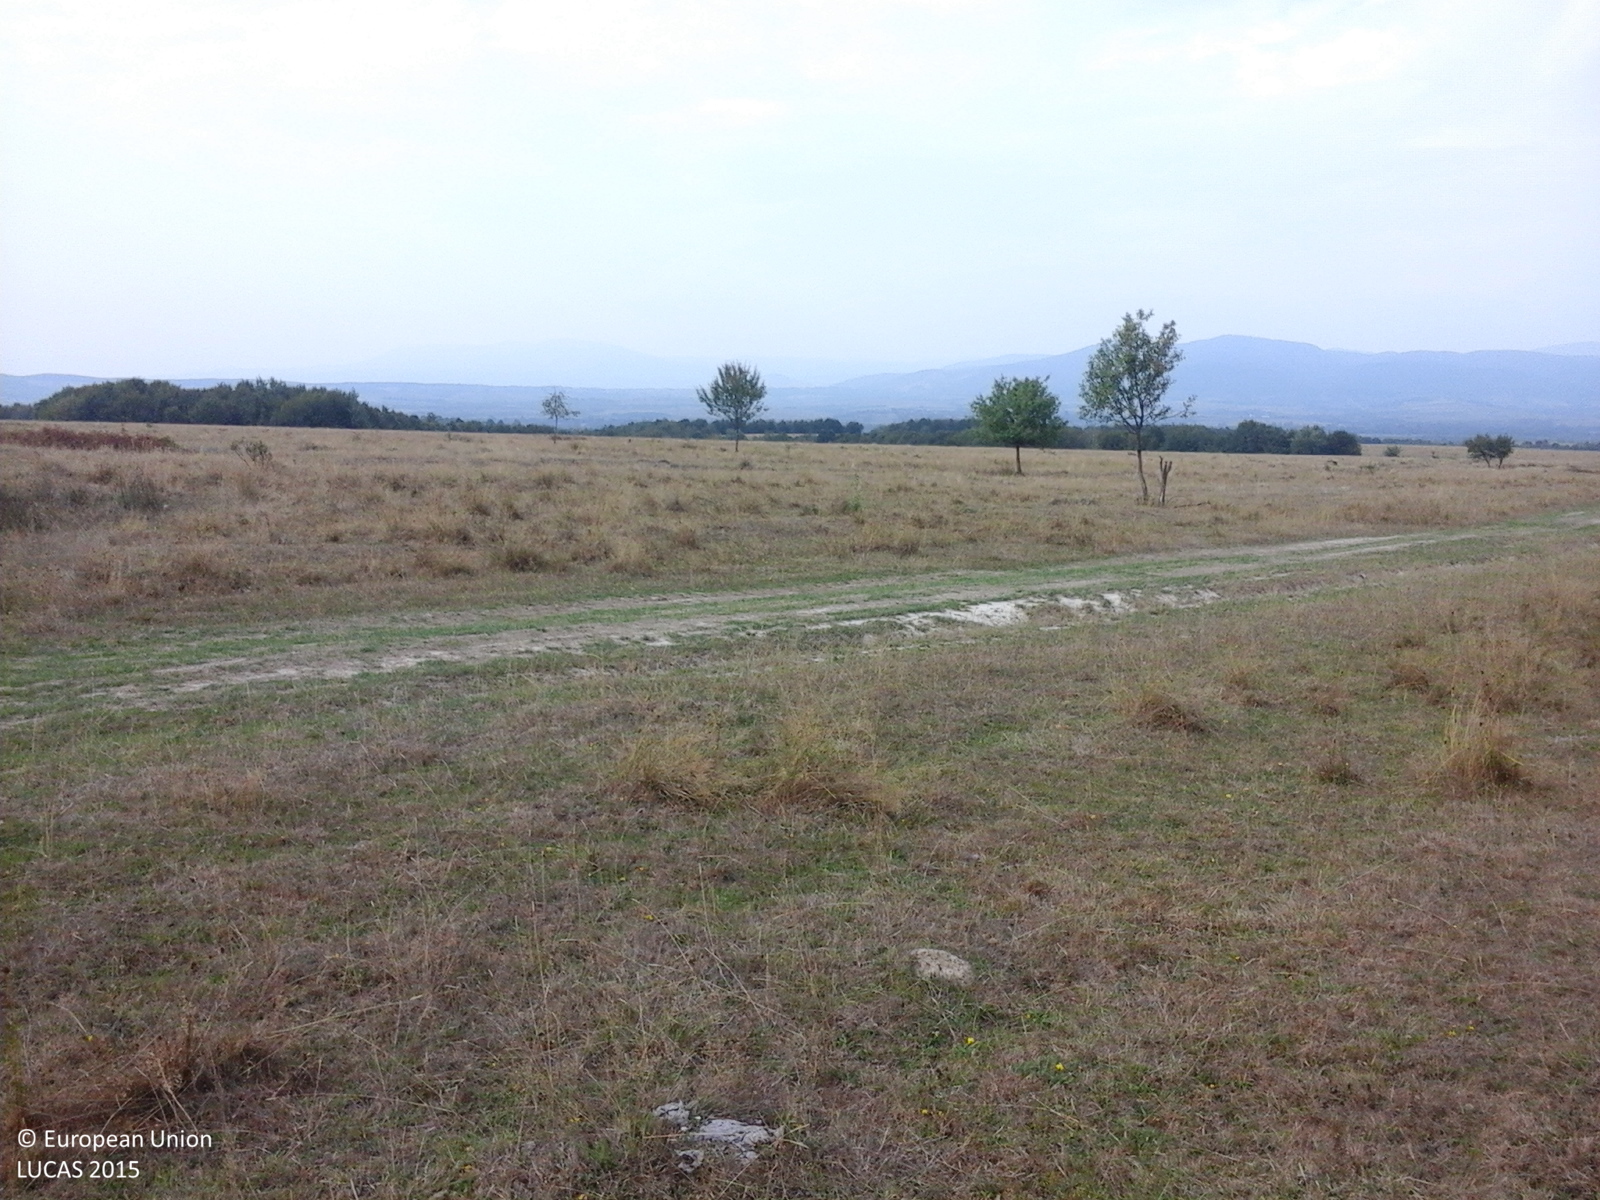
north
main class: Grassland
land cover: Grassland without tree/shrub cover
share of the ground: > 75 %
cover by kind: herbaceous plants 100 %
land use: Agriculture (excluding fallow land and kitchen gardens)
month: August
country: RO
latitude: 46.2655
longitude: 22.2294
